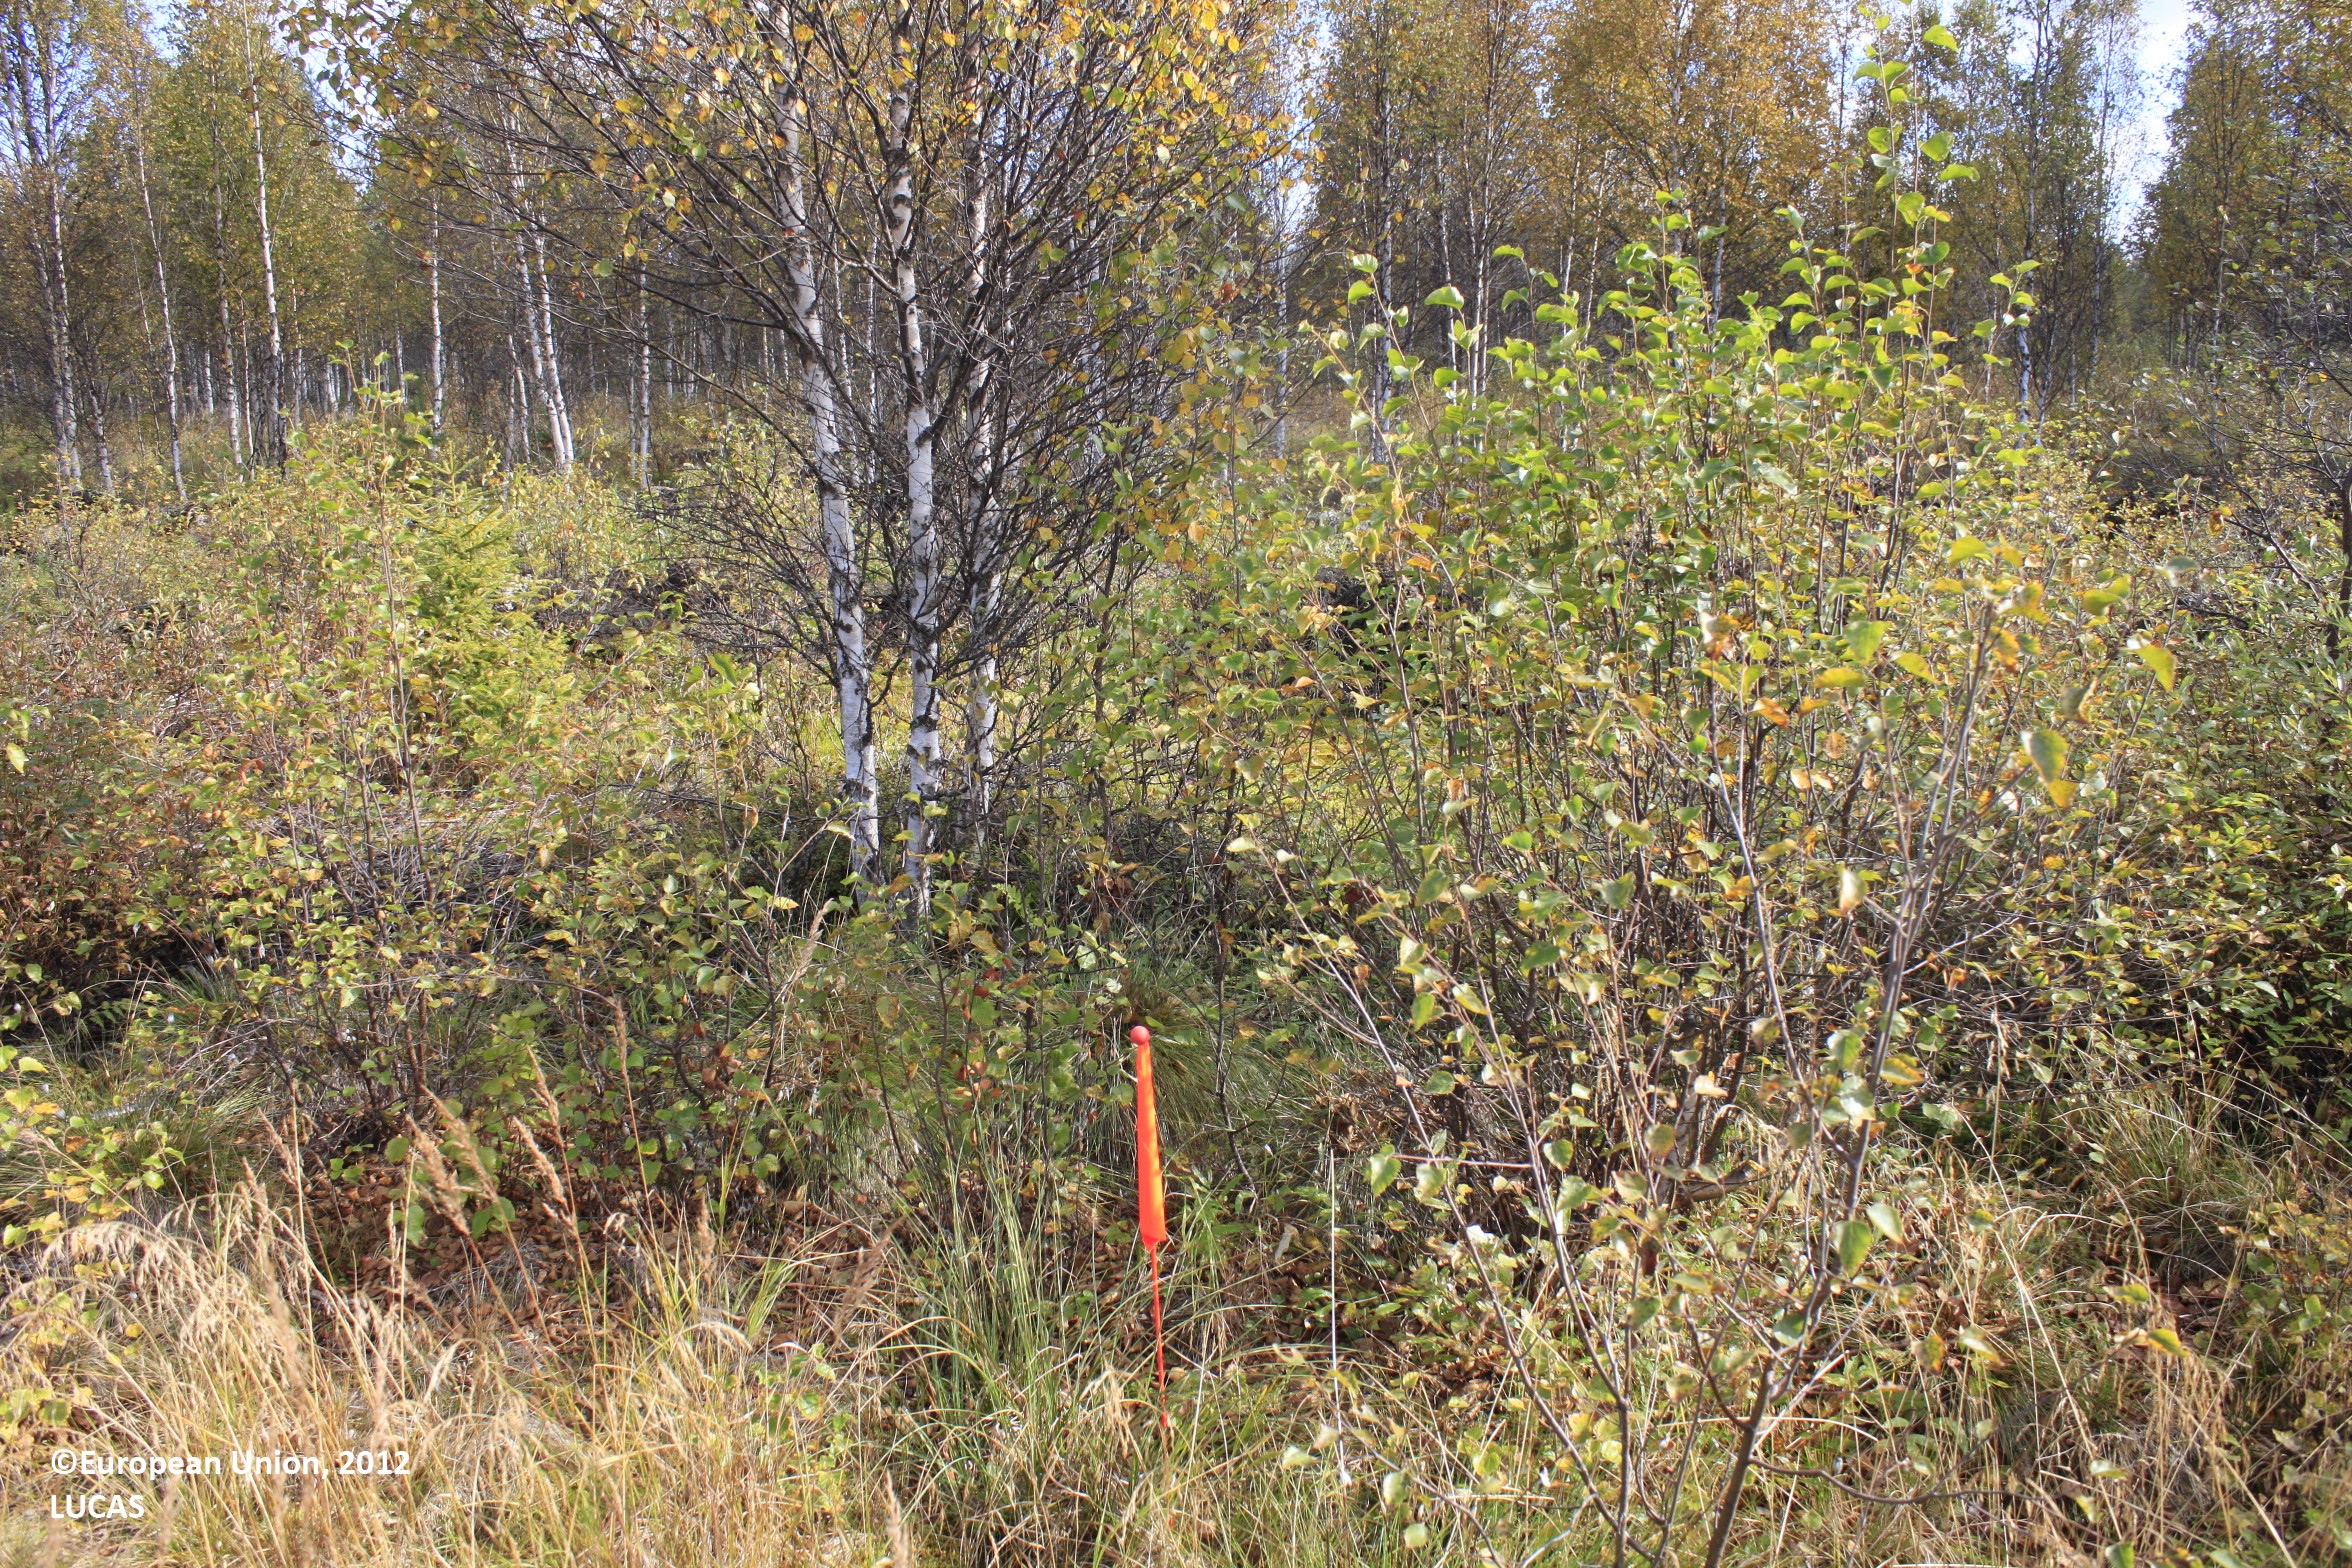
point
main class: Woodland
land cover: Broadleaved woodland
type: boreal forest
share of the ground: 25 - 50 %
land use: Forestry
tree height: < 5 m
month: September
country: FI
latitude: 65.6364
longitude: 26.5462
